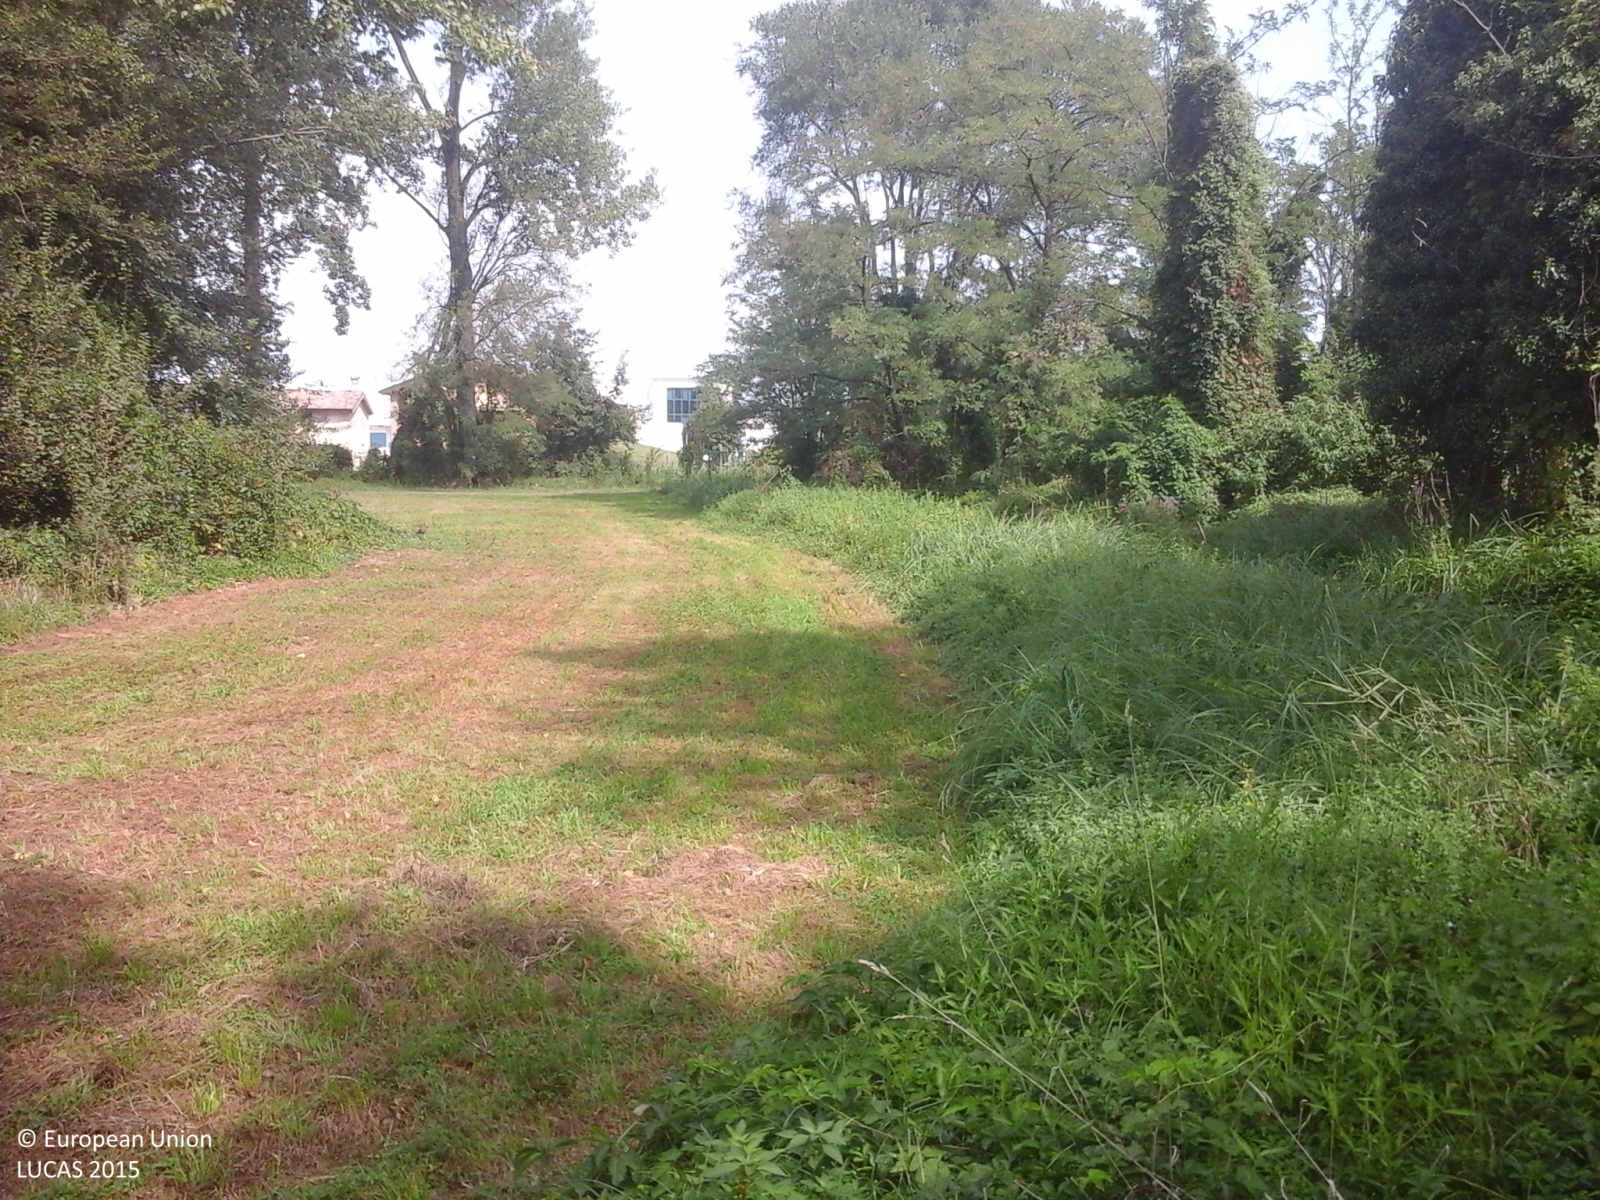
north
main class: Grassland
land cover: Spontaneously vegetated surfaces
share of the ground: > 75 %
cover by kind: herbaceous plants 95 %, shrubs 5 %
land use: Semi-natural and natural areas not in use
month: September
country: IT
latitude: 45.4845
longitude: 9.3742
